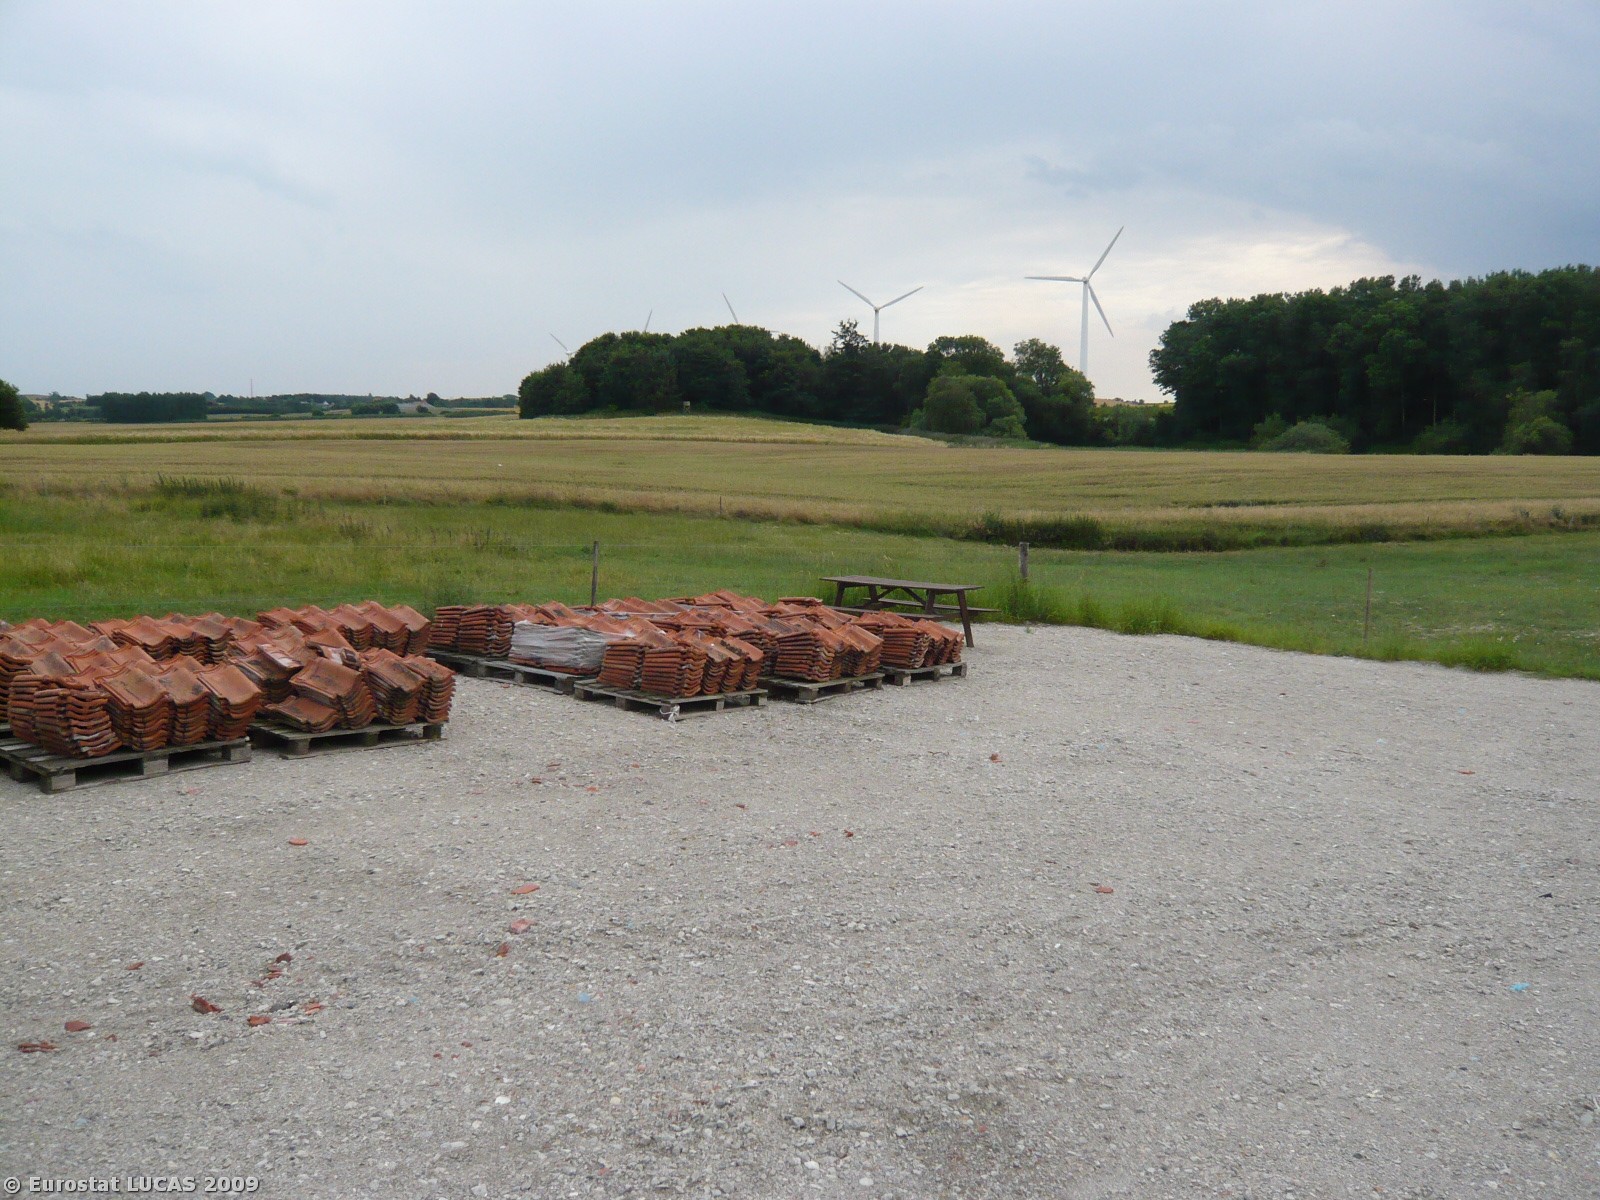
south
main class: Cropland
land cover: Rape and turnip rape
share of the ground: > 75 %
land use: Agriculture (excluding fallow land and kitchen gardens)
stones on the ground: < 10 %
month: July
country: DK
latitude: 55.7308
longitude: 11.3841
